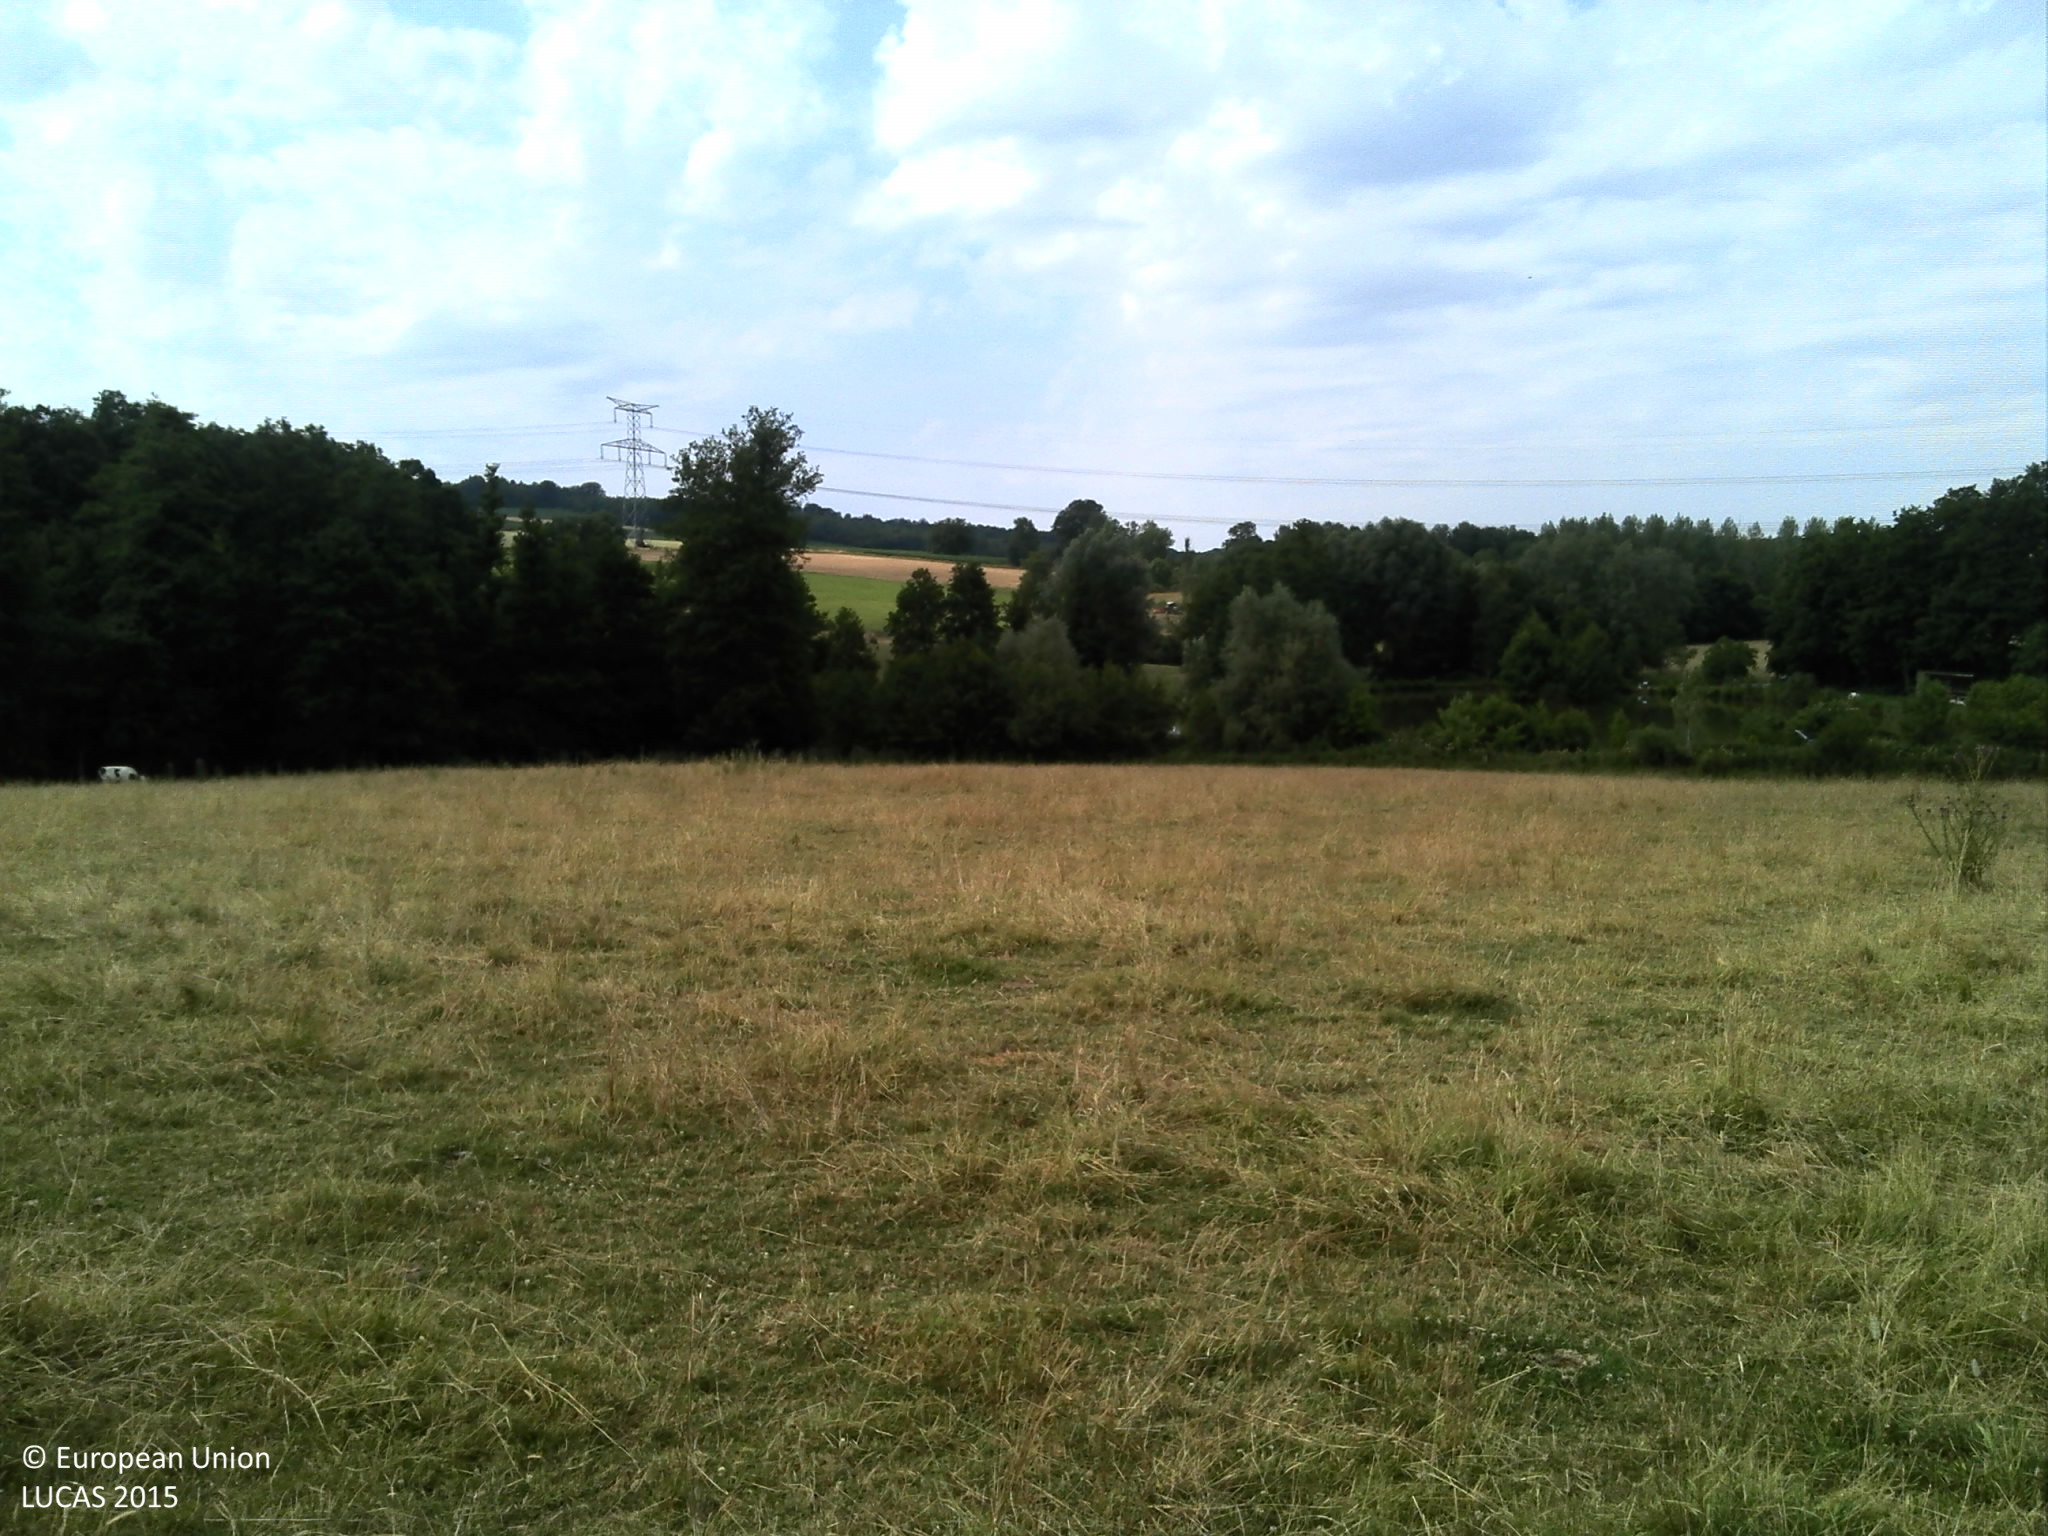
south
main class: Grassland
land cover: Grassland without tree/shrub cover
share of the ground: > 75 %
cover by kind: herbaceous plants 100 %
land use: Agriculture (excluding fallow land and kitchen gardens)
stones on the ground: < 10 %
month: July
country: FR
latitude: 49.7358
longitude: 4.6825
